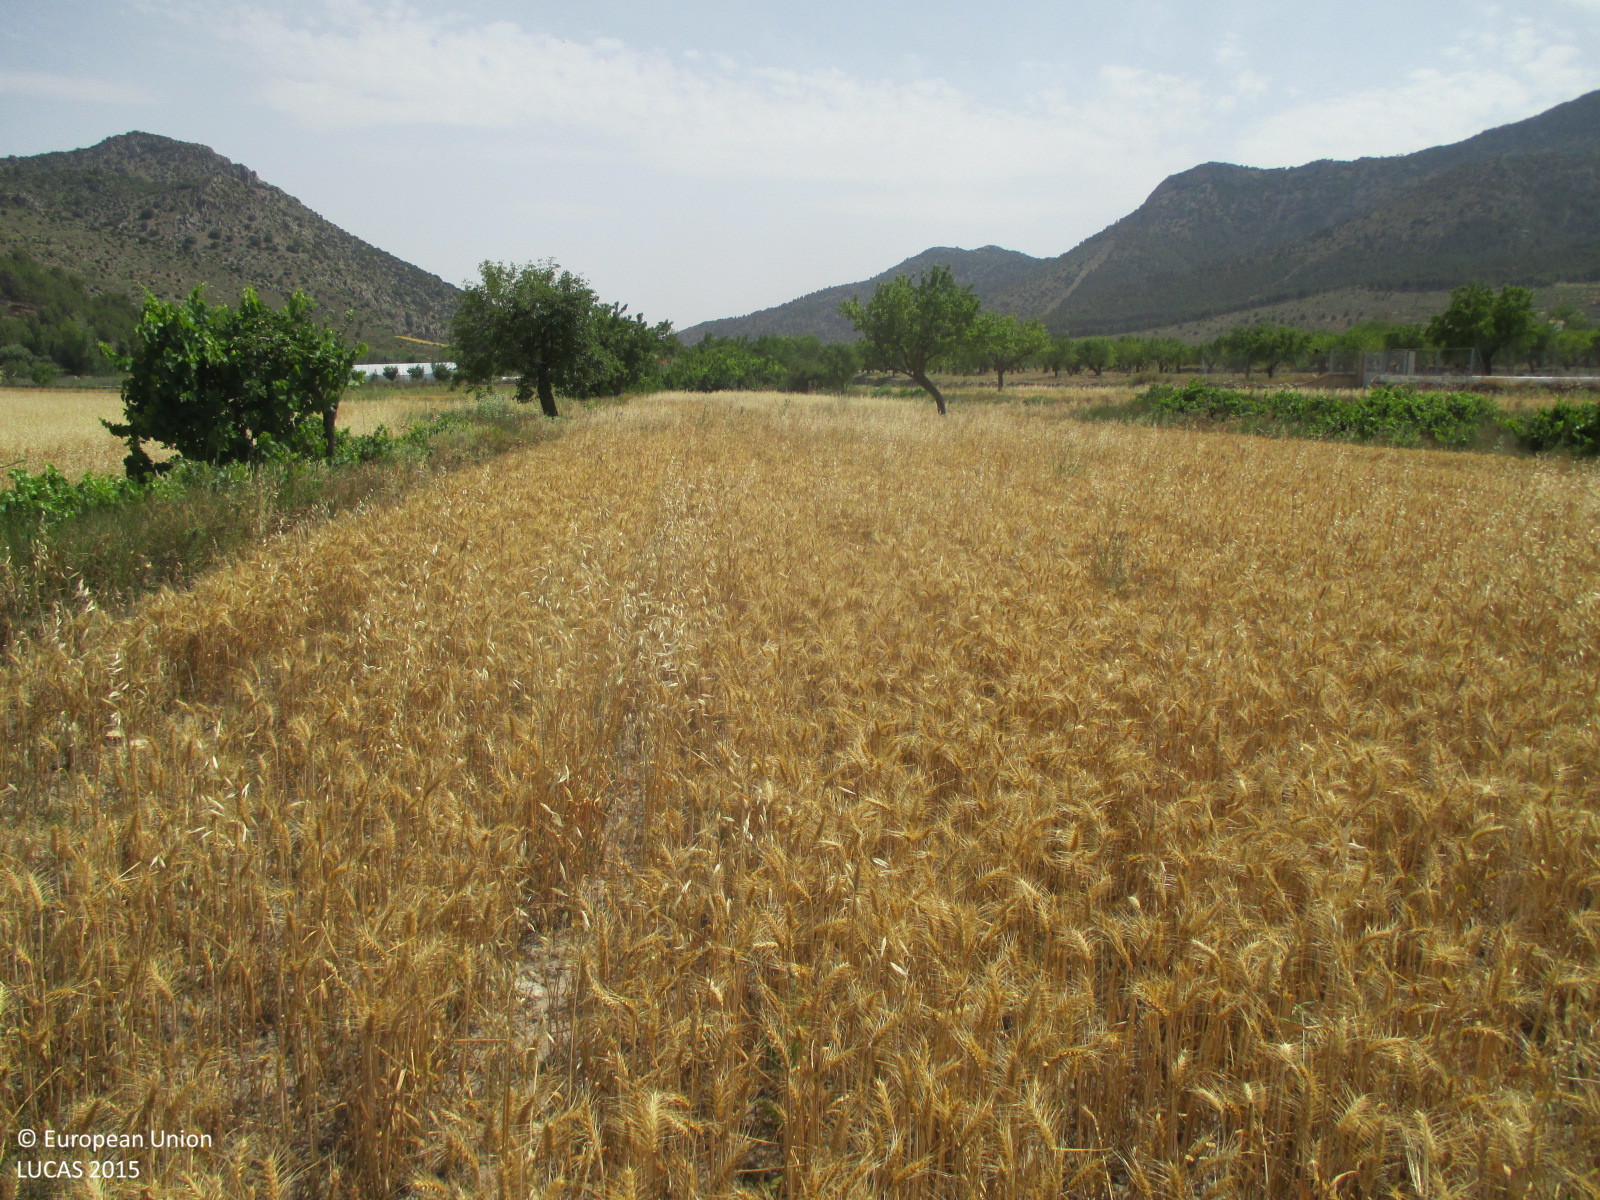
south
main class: Cropland
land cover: Common wheat
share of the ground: 50 - 75 %
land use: Agriculture (excluding fallow land and kitchen gardens)
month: July
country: ES
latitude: 37.9546
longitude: -2.4305
